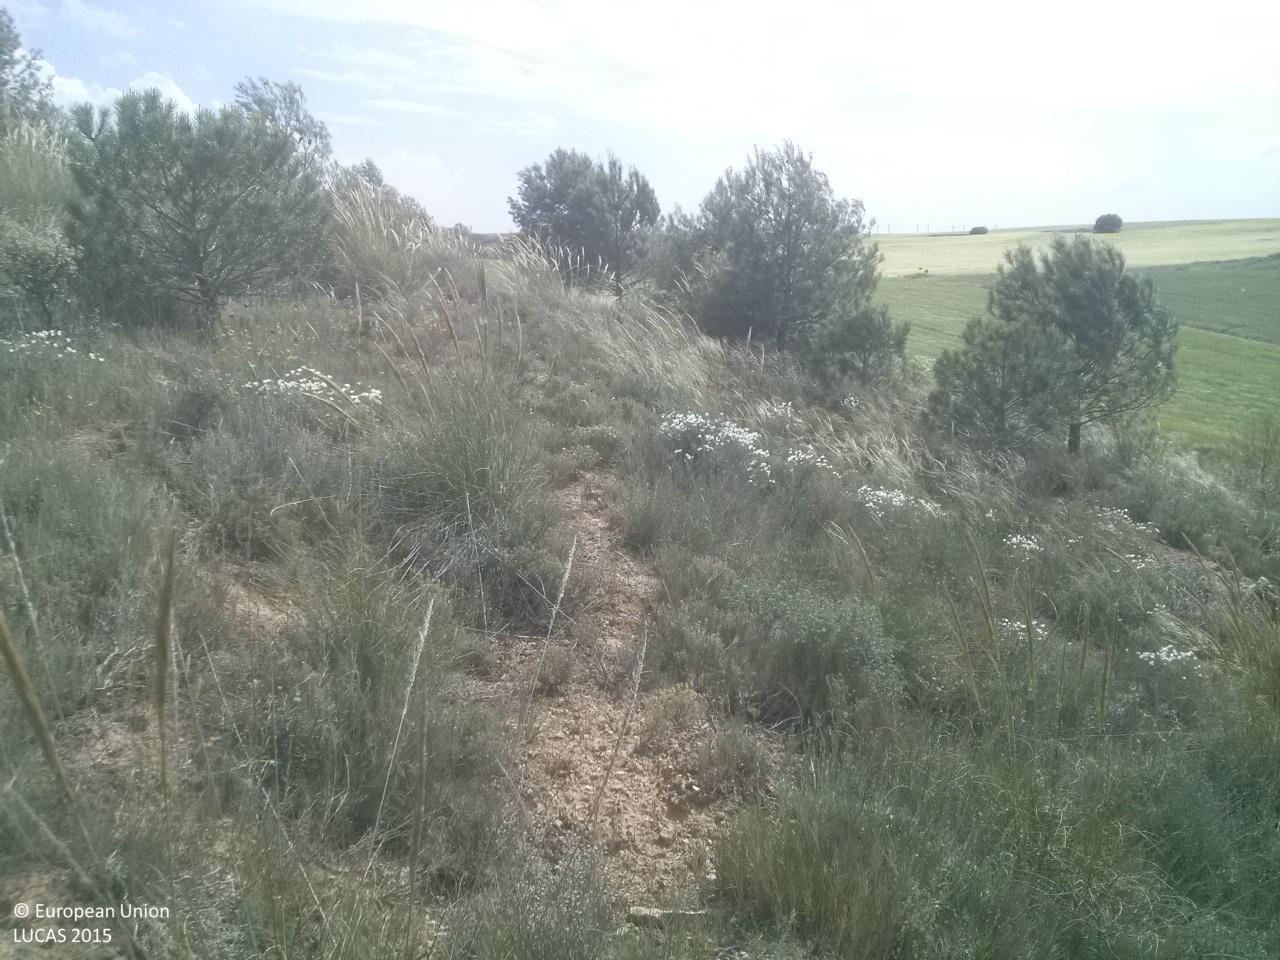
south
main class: Woodland
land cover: Pine dominated mixed woodland
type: coniferous forest of the mediterranean region
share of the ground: 10 - 25 %
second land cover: Shrubland without tree cover
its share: 50 - 75 %
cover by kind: shrubs 55 %, coniferous forest trees 20 %, herbaceous plants 15 %, broadleaved forest trees 10 %
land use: Forestry
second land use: Agriculture (excluding fallow land and kitchen gardens)
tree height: < 5 m
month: May
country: ES
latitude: 40.0158
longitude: -2.8985
